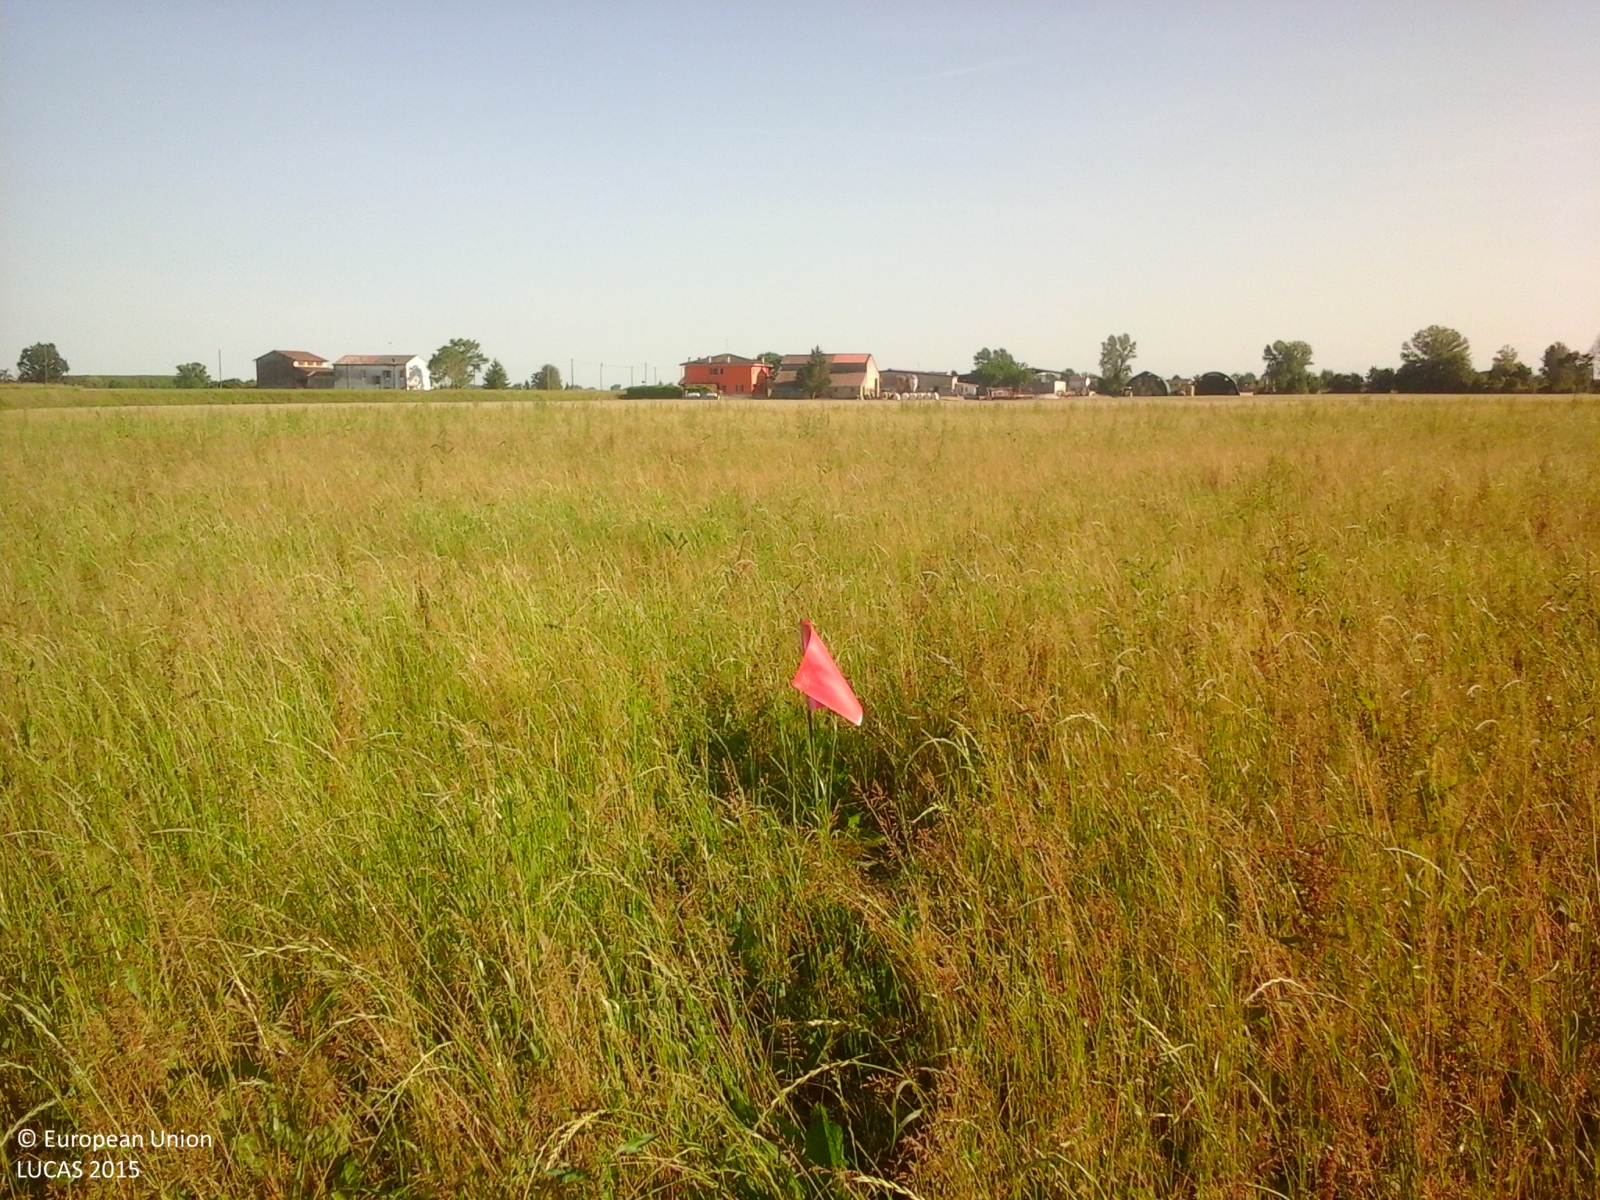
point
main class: Cropland
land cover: Temporary grasslands
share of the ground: > 75 %
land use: Agriculture (excluding fallow land and kitchen gardens)
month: May
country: IT
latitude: 44.9776
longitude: 10.9239
